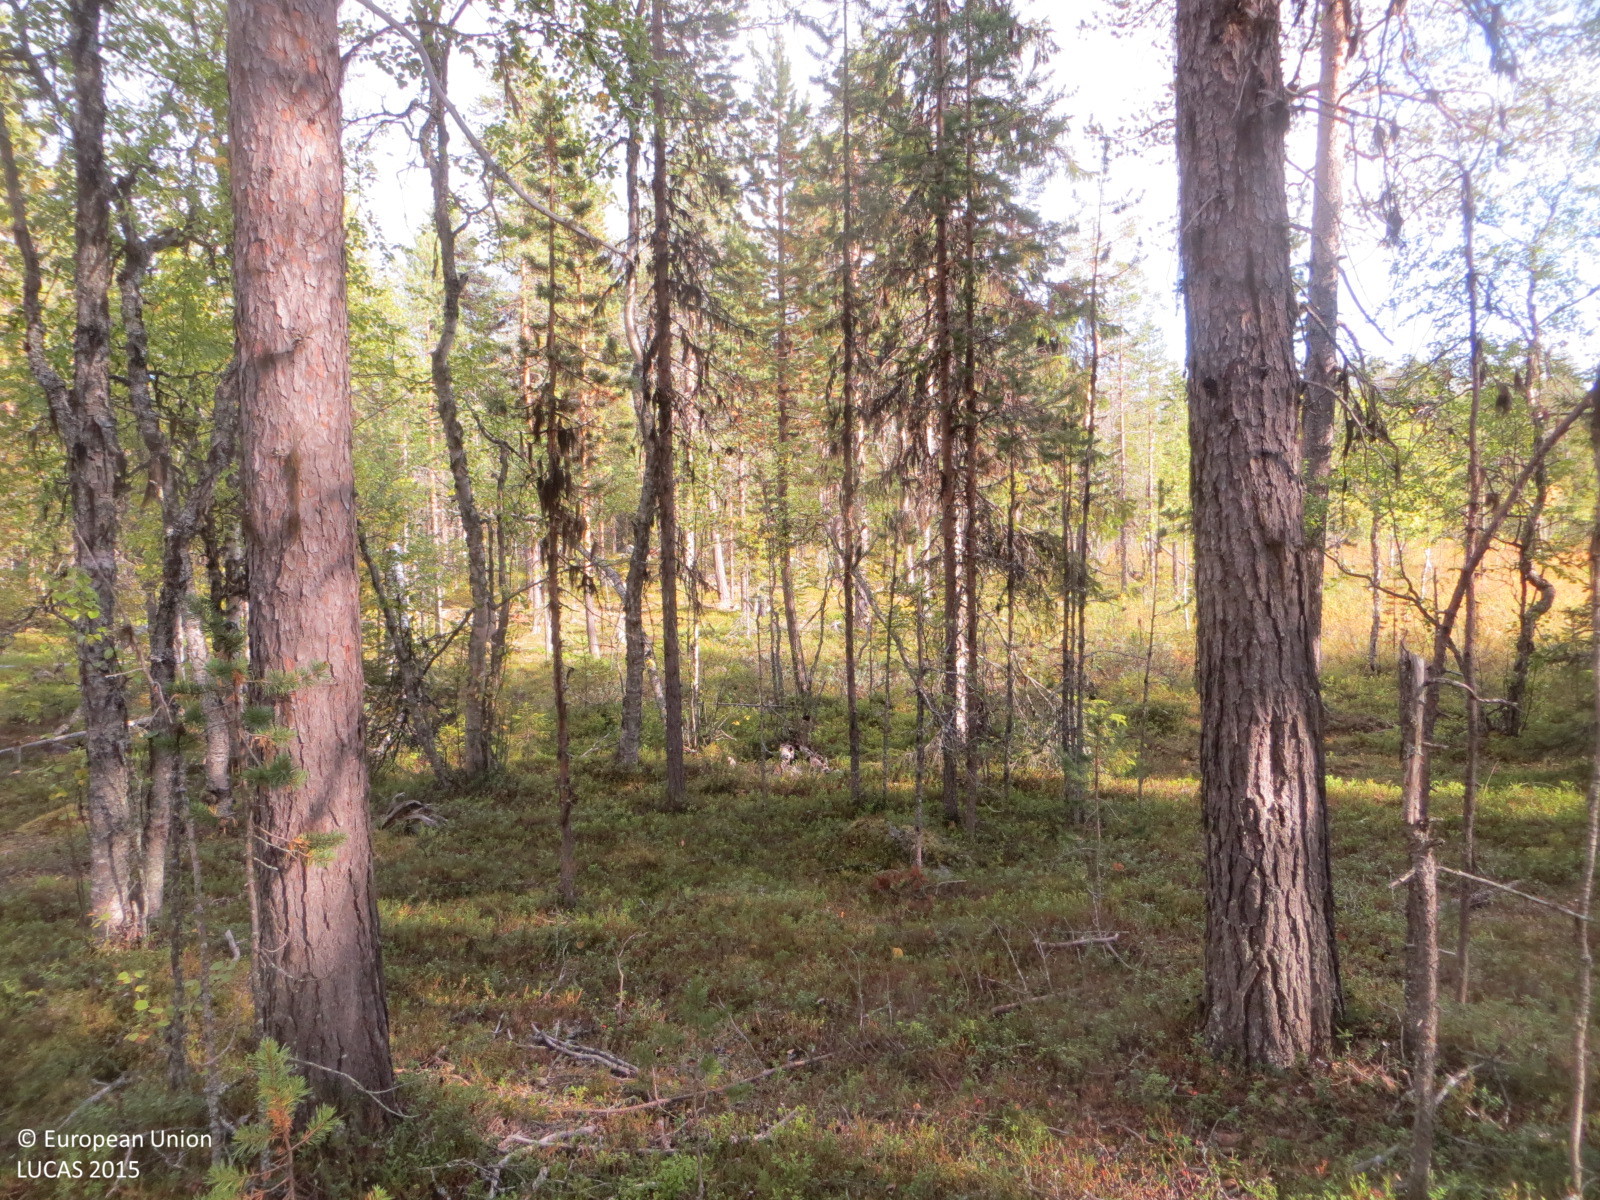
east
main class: Woodland
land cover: Other coniferous woodland
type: boreal forest
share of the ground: 50 - 75 %
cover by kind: coniferous forest trees 50 %, shrubs 50 %
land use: Semi-natural and natural areas not in use
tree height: > 5 m
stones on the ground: < 10 %
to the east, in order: Other coniferous woodland; Pine dominated mixed woodland
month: September
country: FI
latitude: 67.9583
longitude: 24.0332
